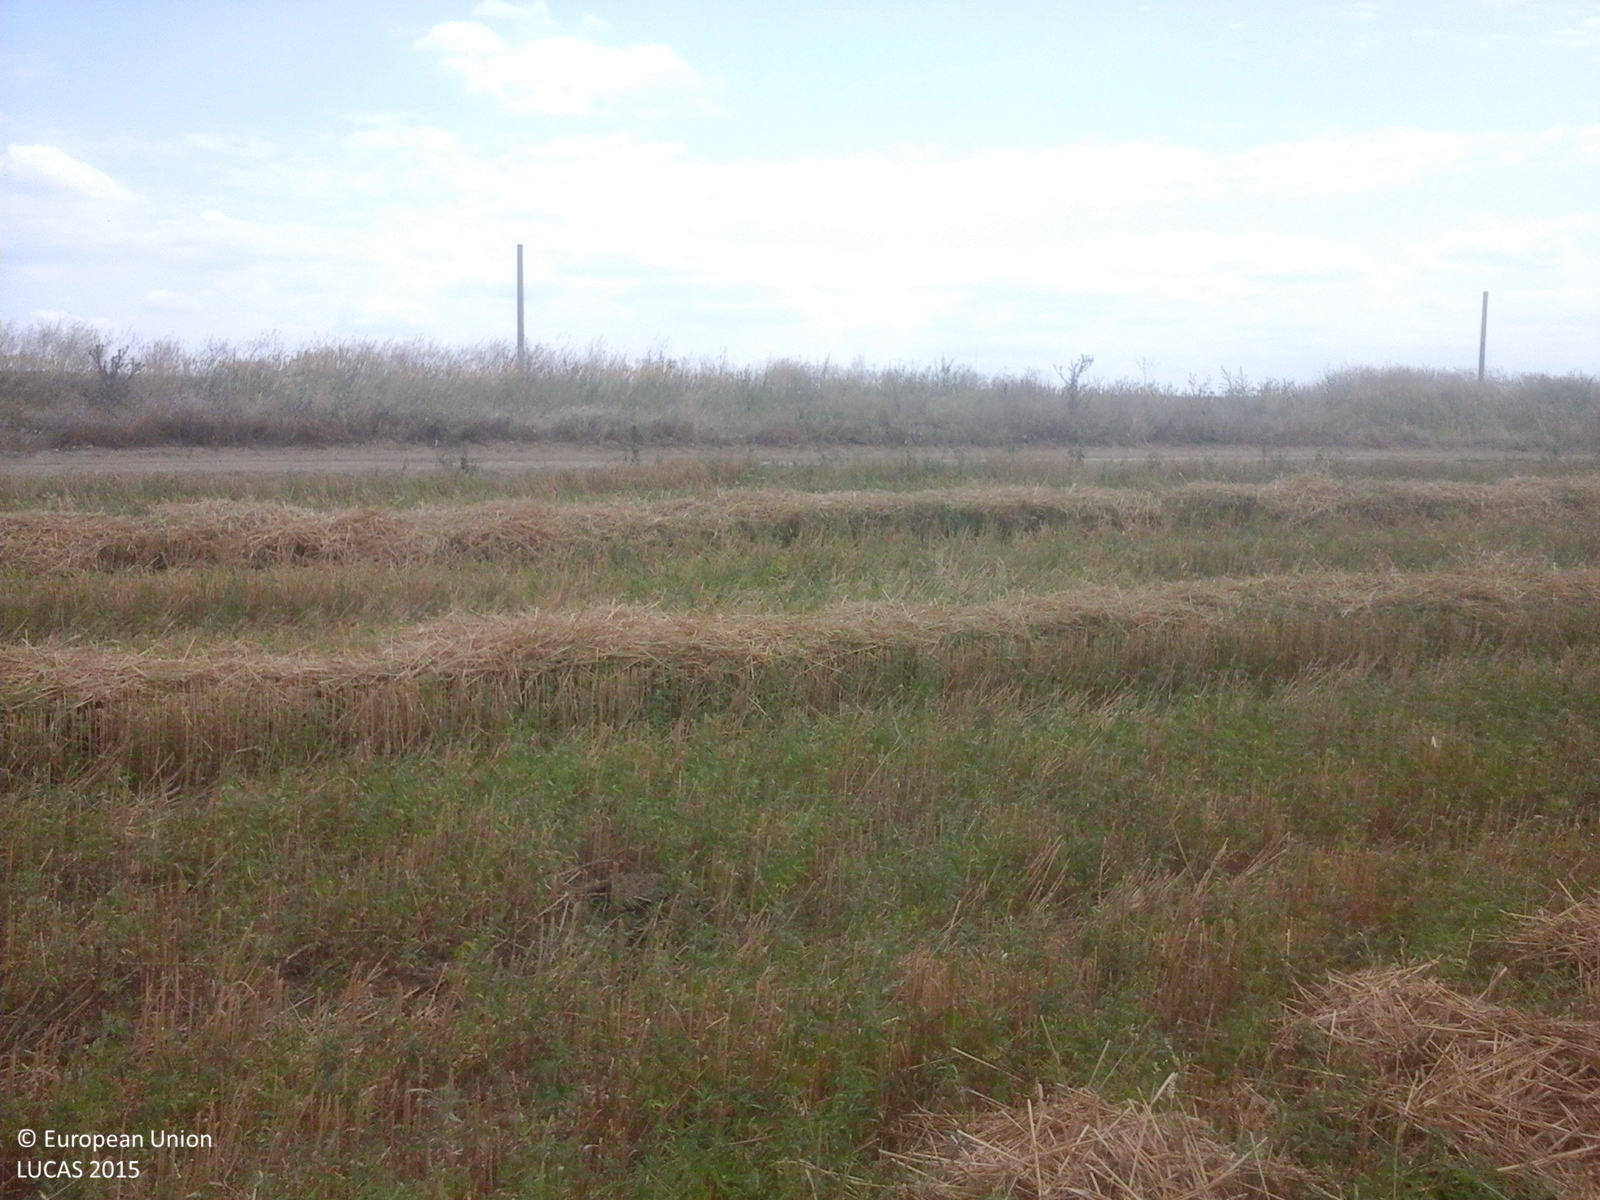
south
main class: Cropland
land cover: Common wheat
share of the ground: 25 - 50 %
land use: Agriculture (excluding fallow land and kitchen gardens)
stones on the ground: < 10 %
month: August
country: RO
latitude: 44.7727
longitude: 28.1989
